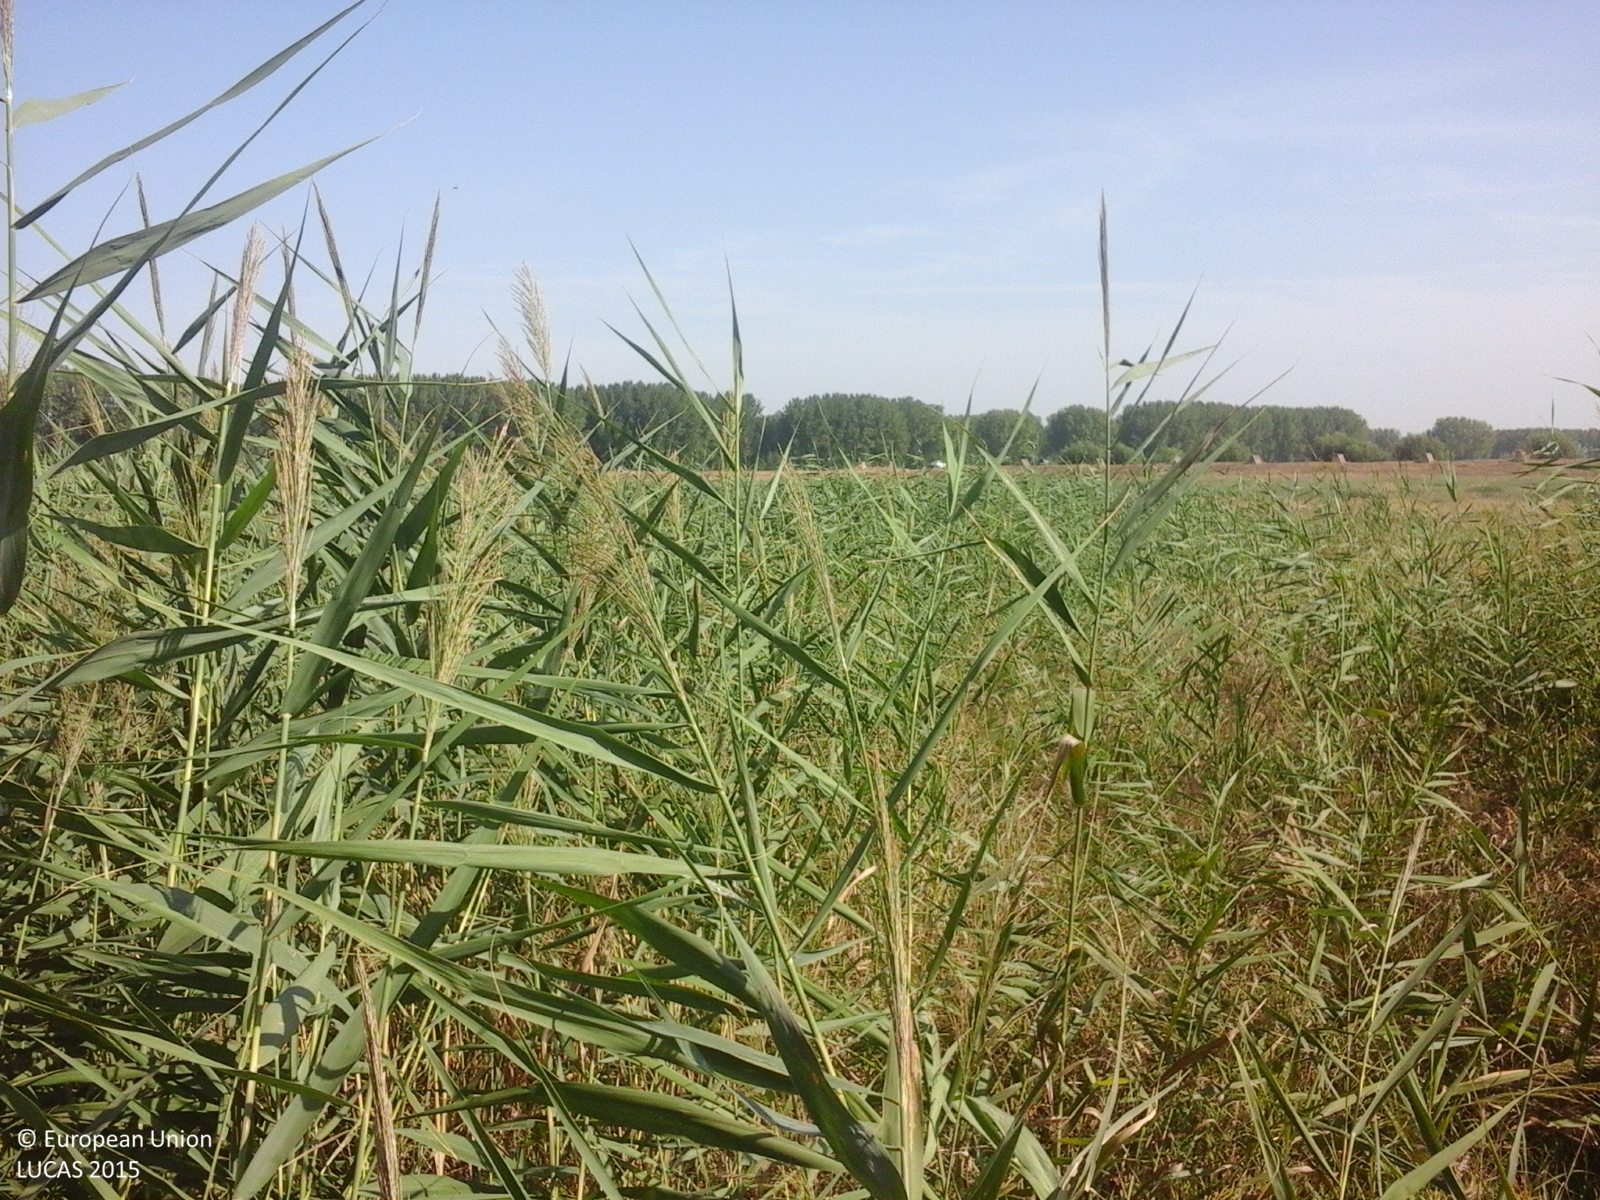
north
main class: Grassland
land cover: Spontaneously vegetated surfaces
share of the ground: > 75 %
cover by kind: herbaceous plants 100 %
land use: Semi-natural and natural areas not in use
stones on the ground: < 10 %
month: August
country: RO
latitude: 43.9627
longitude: 22.8889
